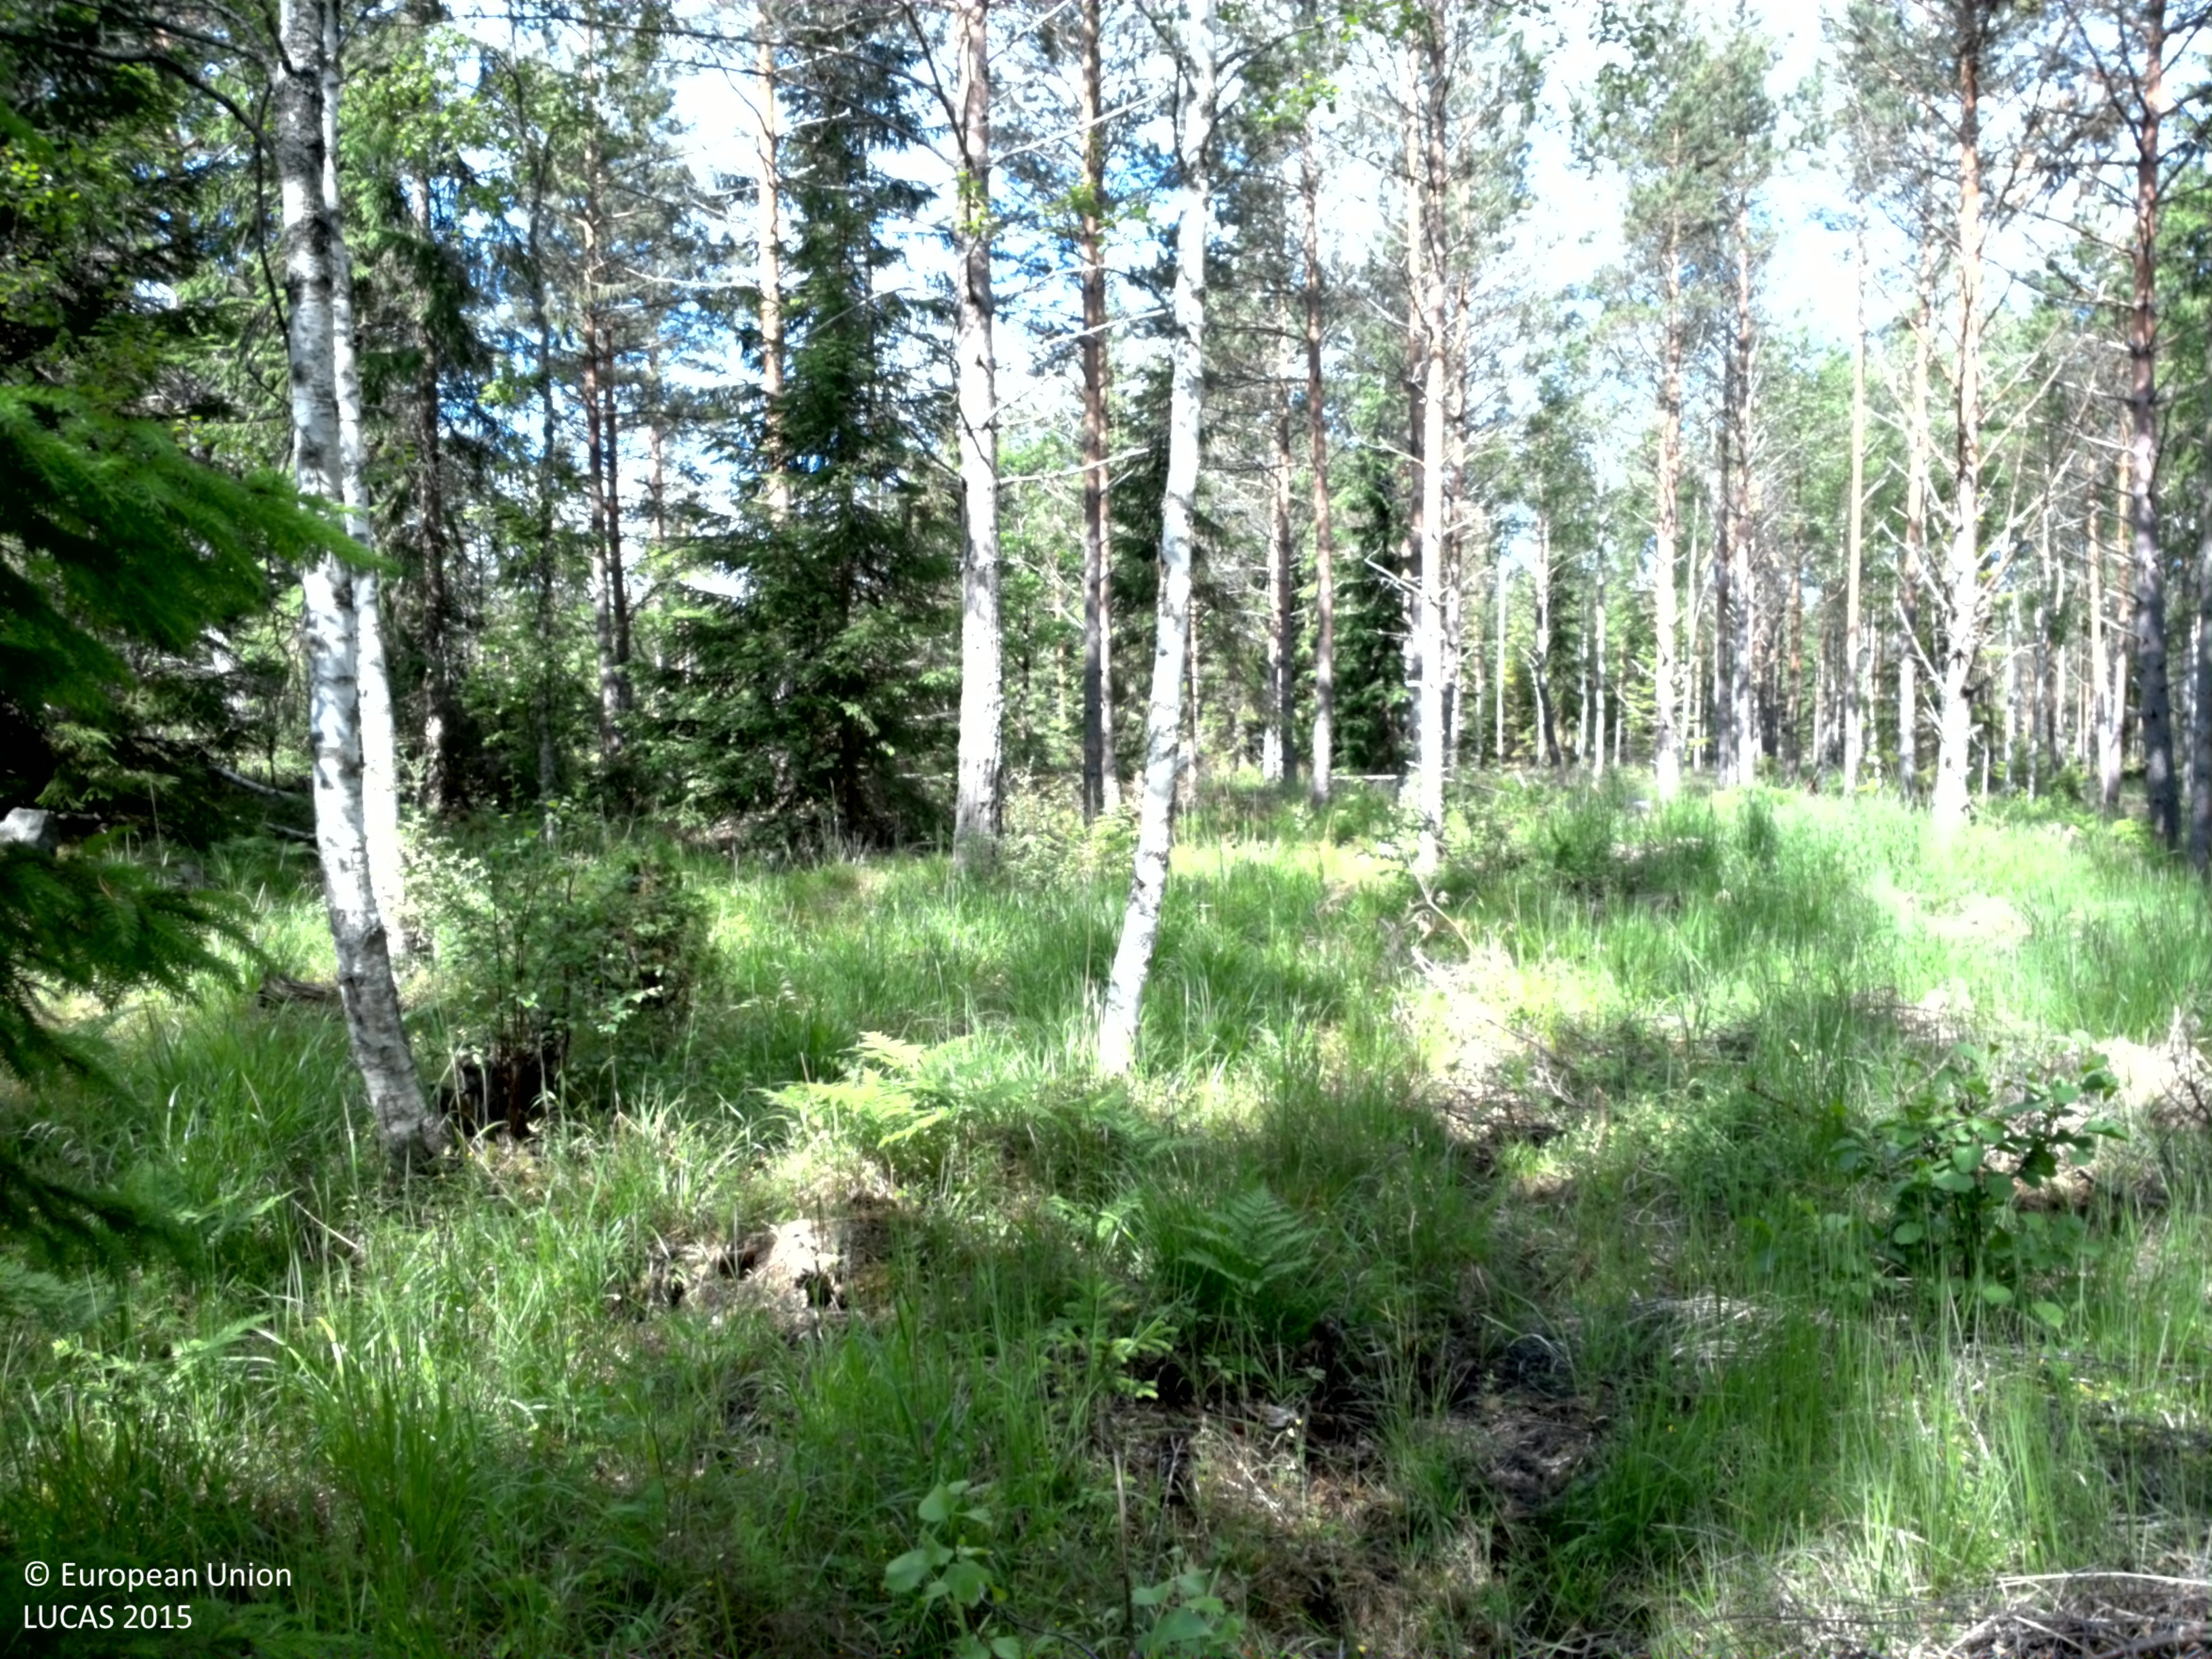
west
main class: Woodland
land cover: Pine dominated mixed woodland
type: boreal forest
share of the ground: 50 - 75 %
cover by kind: coniferous forest trees 45 %, herbaceous plants 25 %, broadleaved forest trees 15 %, lichens and mosses 15 %
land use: Forestry
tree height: > 5 m
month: June
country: SE
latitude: 60.1091
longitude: 18.4338
